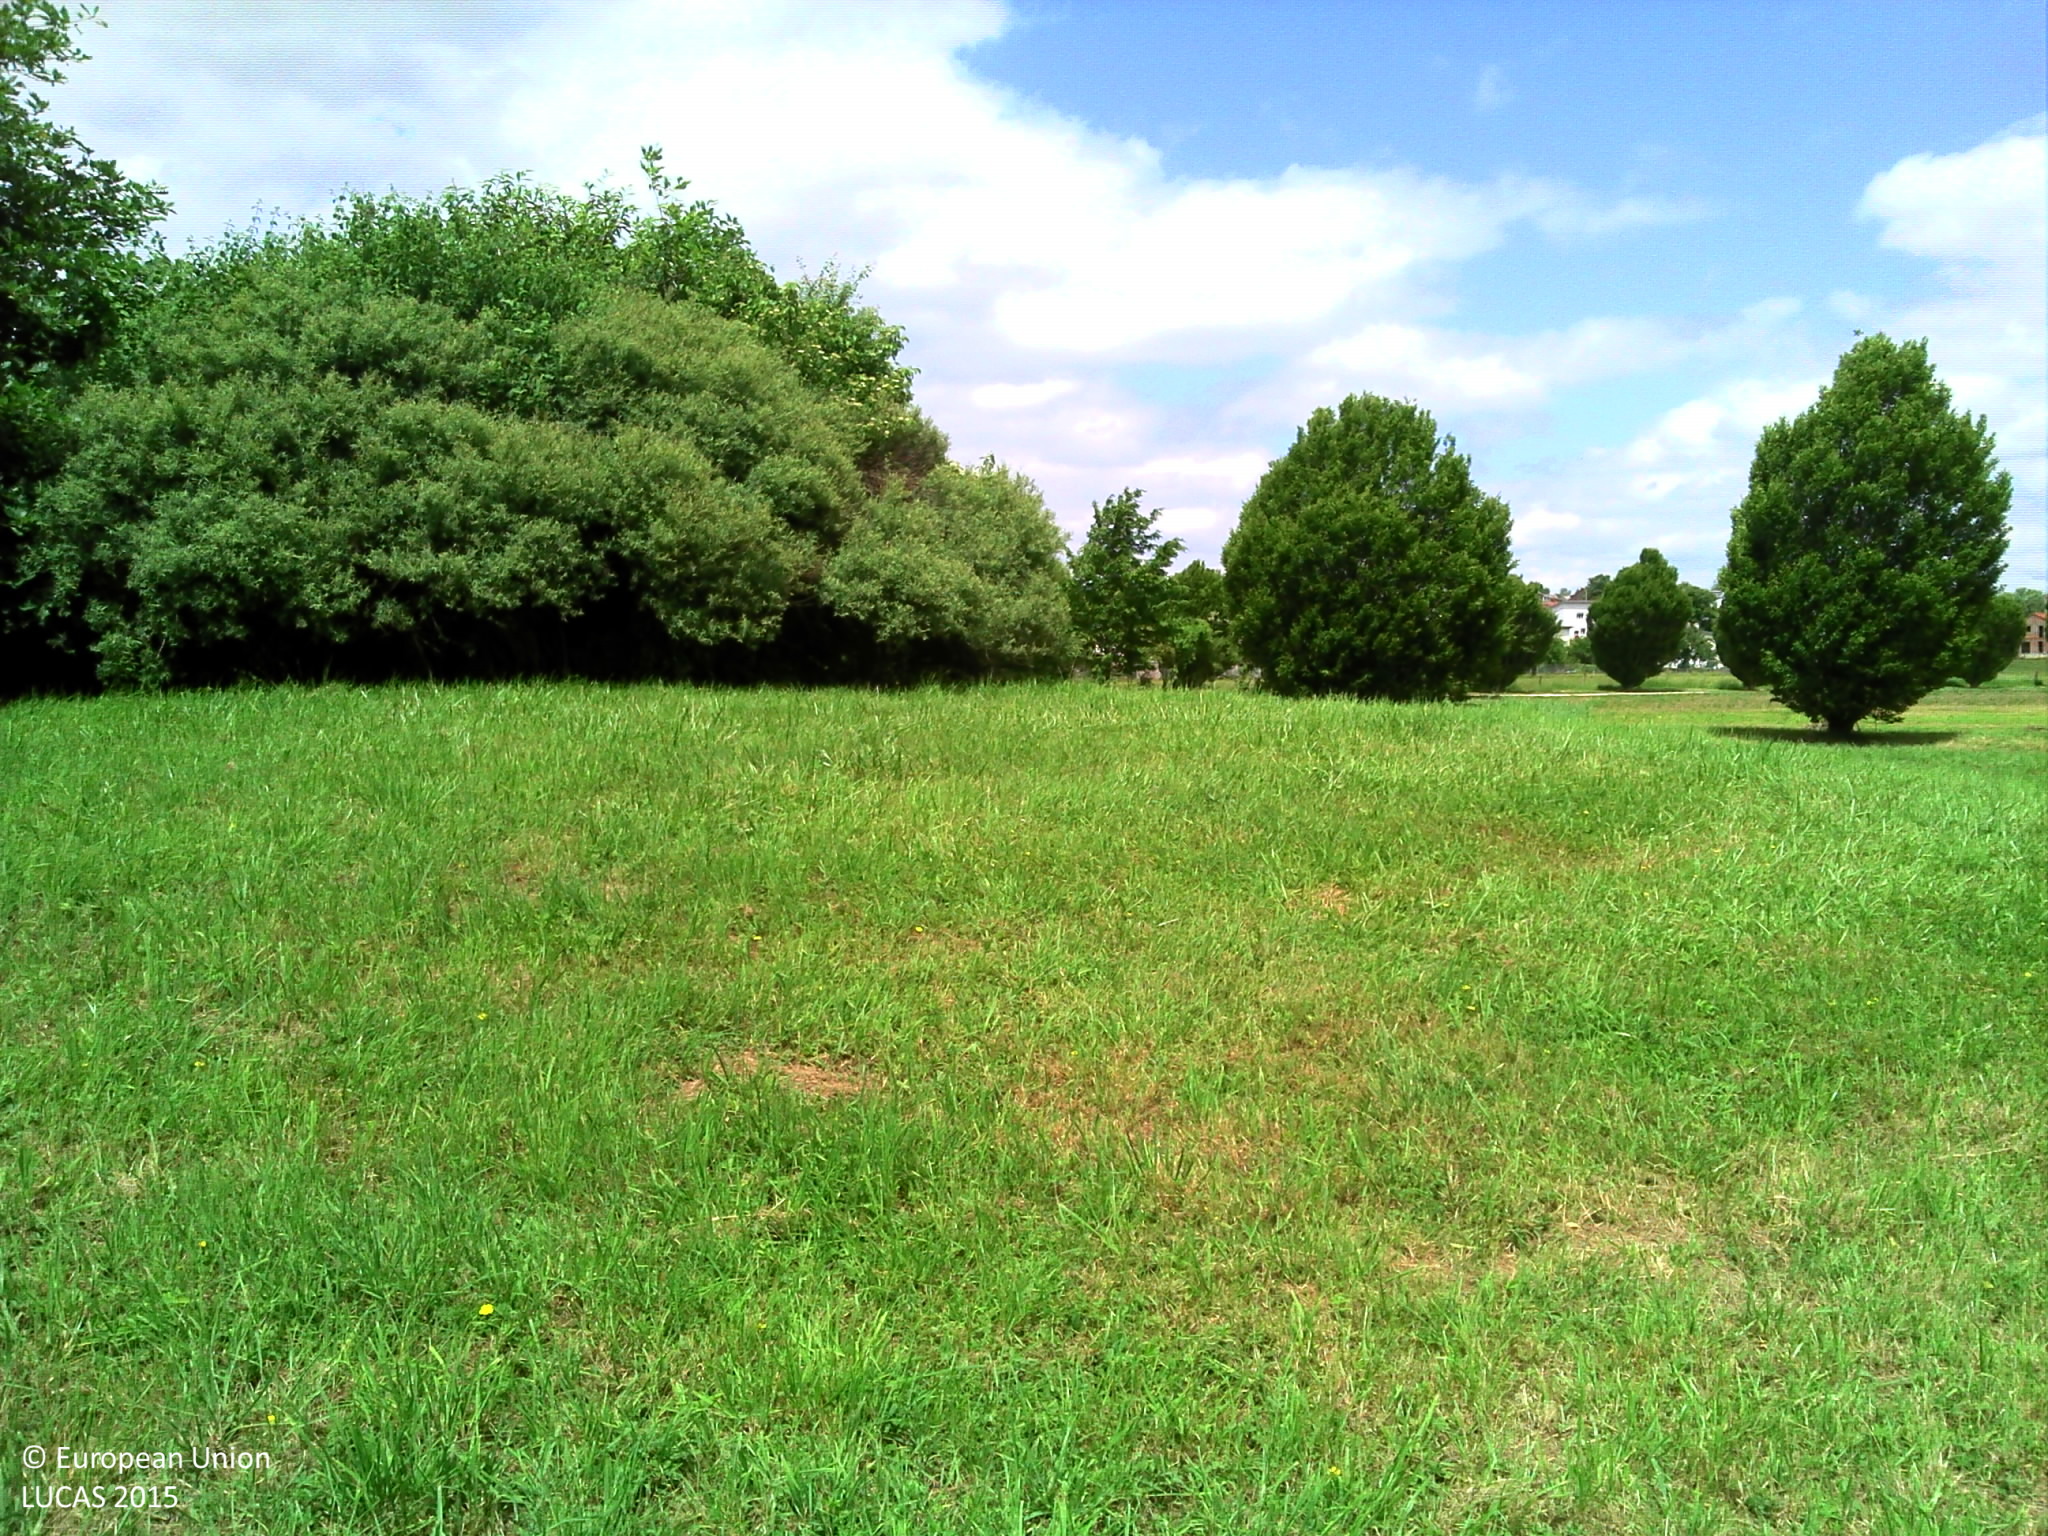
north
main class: Grassland
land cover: Grassland with sparse tree/shrub cover
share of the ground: > 75 %
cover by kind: herbaceous plants 95 %, broadleaved forest trees 5 %
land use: Amenities, museums, leisure
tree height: < 5 m
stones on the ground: < 10 %
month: June
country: FR
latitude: 48.6817
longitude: 6.2378
